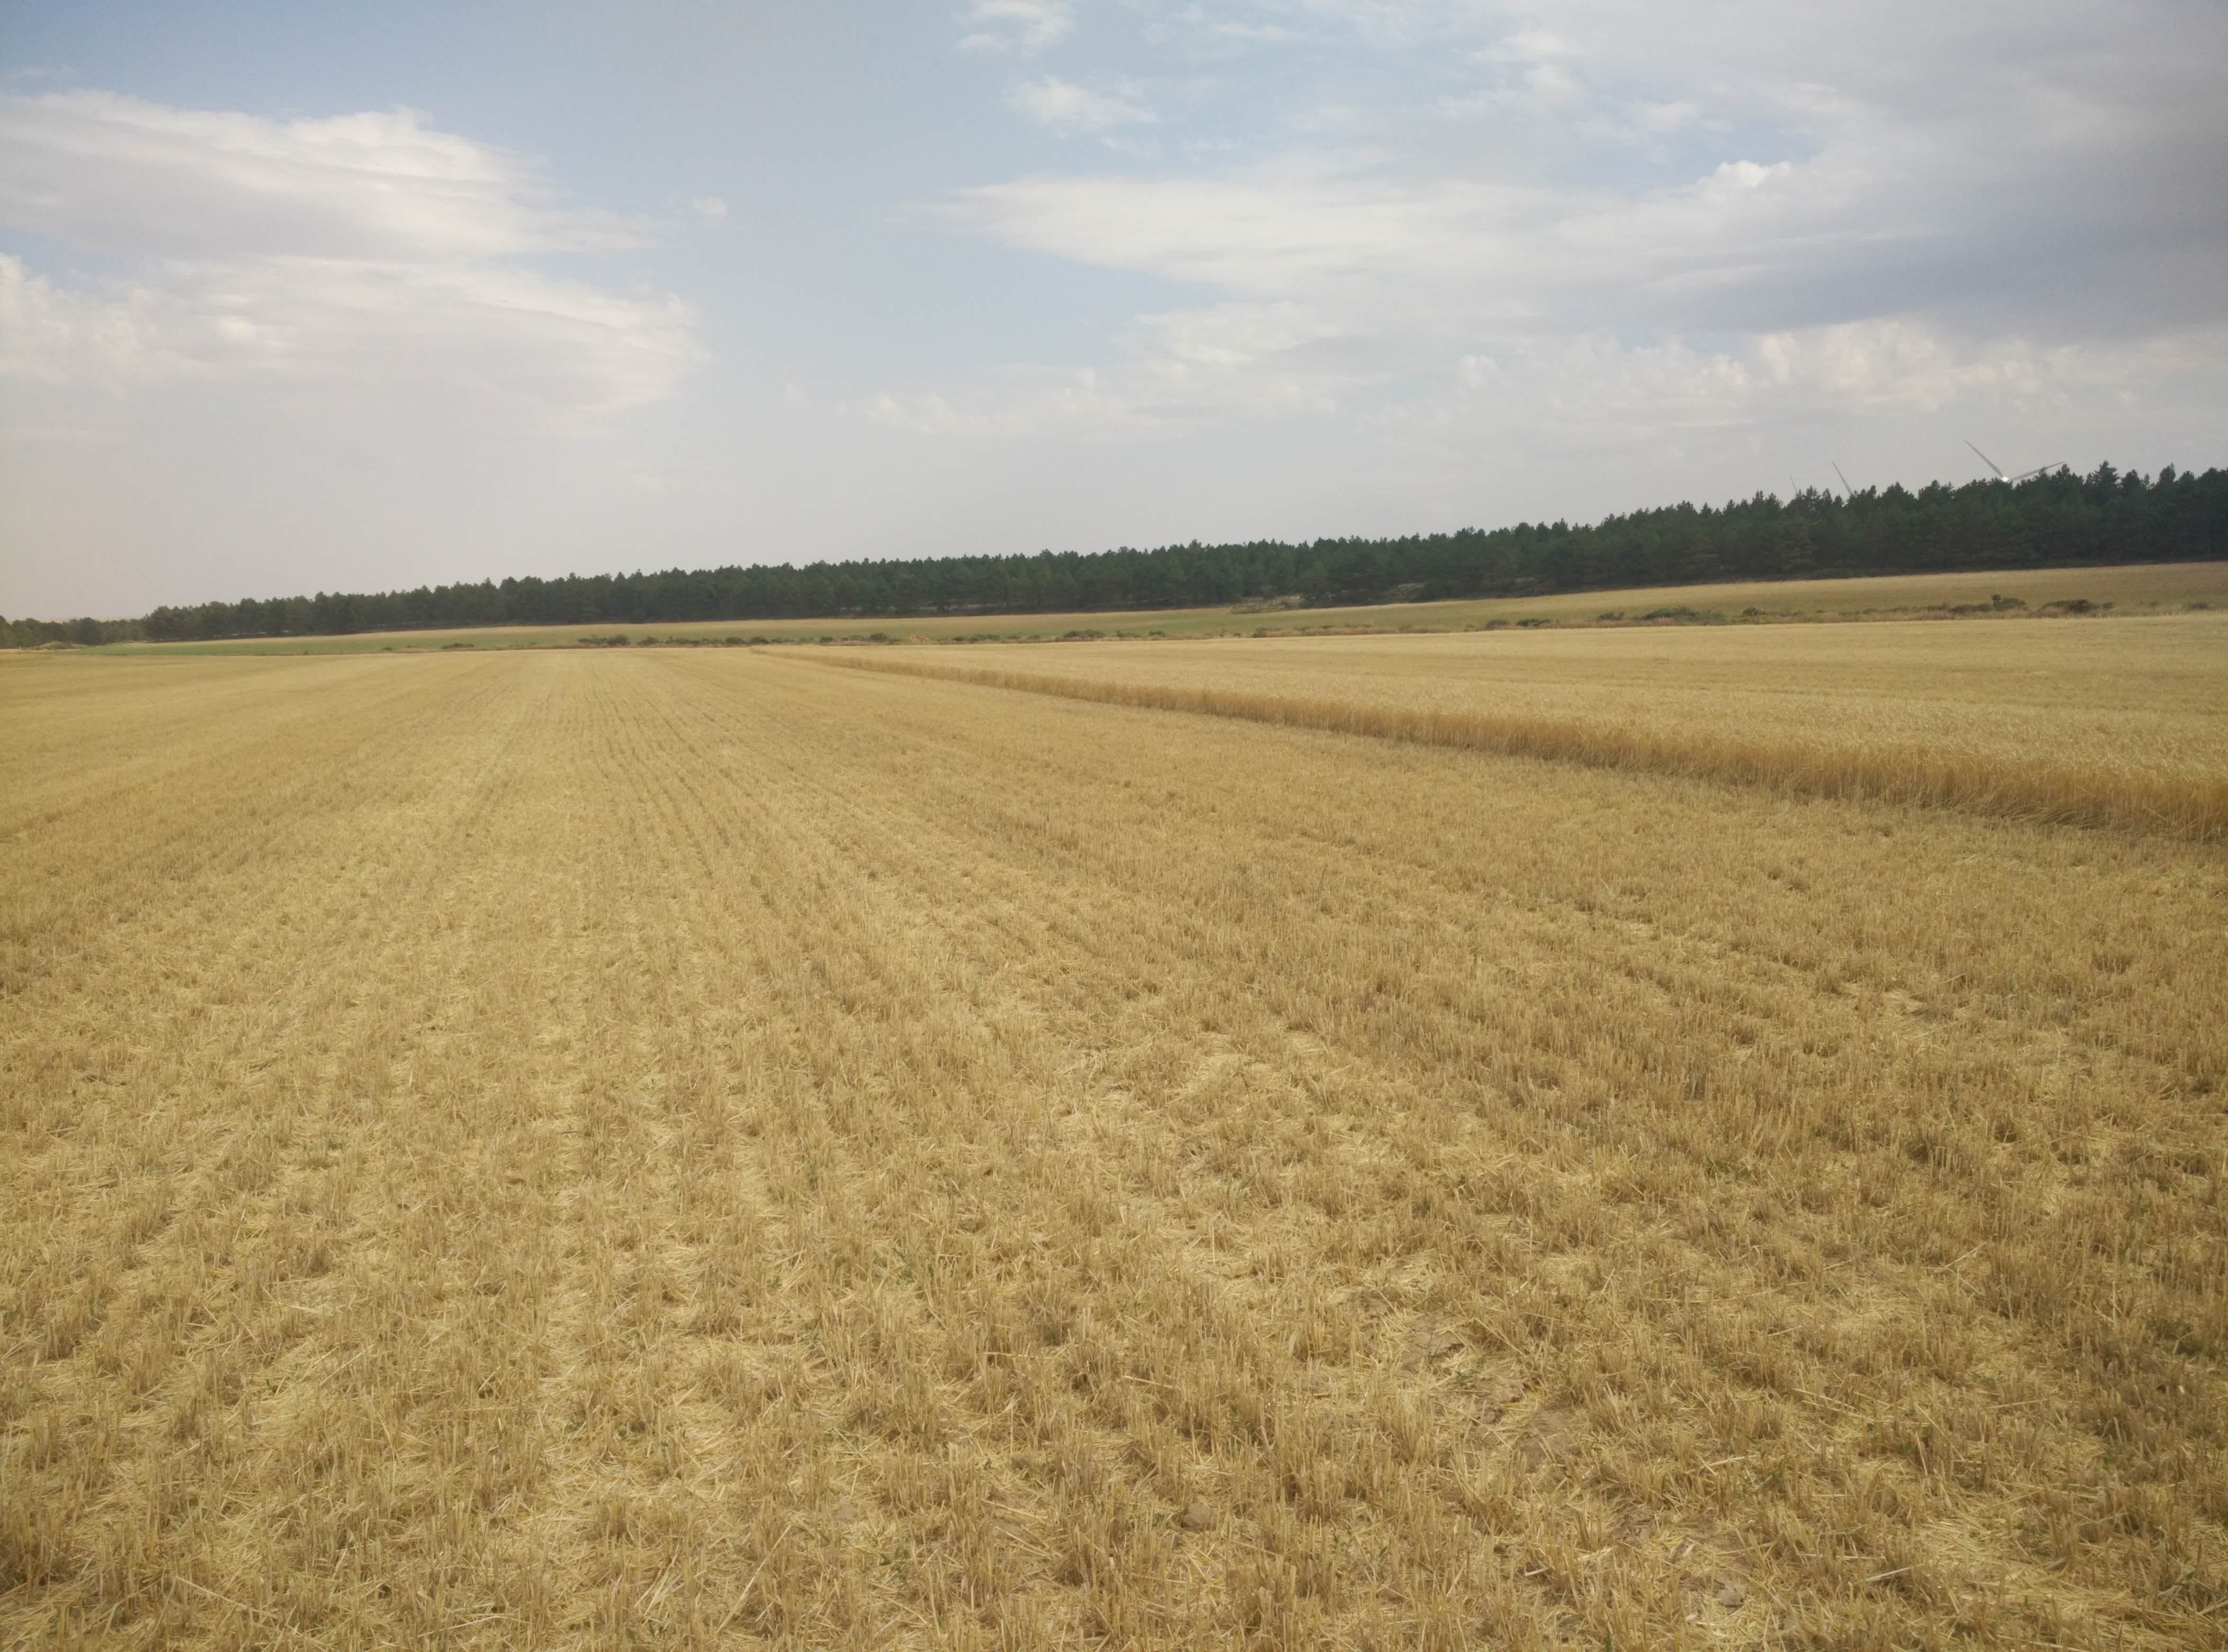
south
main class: Cropland
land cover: Barley
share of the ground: < 10 %
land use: Agriculture (excluding fallow land and kitchen gardens)
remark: Harvested field
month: July
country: ES
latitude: 41.0246
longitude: -1.8573
